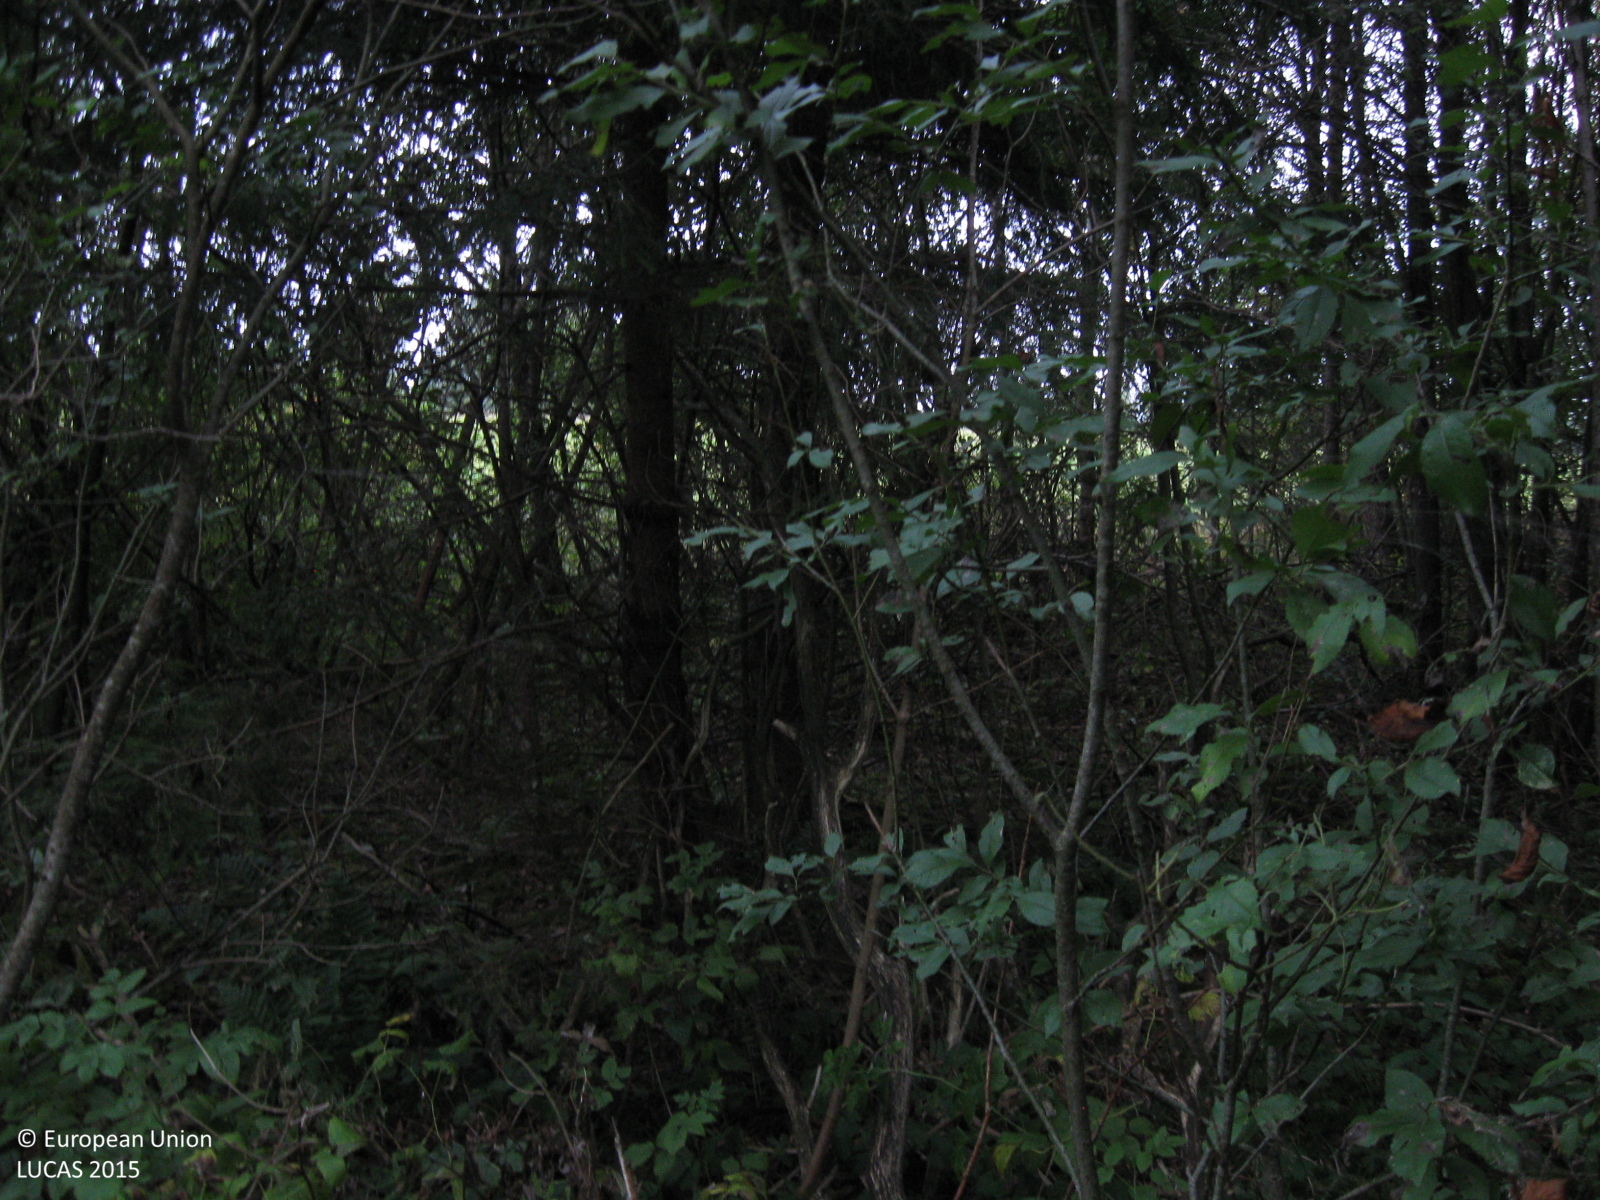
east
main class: Woodland
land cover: Broadleaved woodland
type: non-riverine alder, birch or aspen forest
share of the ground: > 75 %
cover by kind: broadleaved forest trees 90 %, coniferous forest trees 5 %, herbaceous plants 5 %
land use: Forestry
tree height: > 5 m
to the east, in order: Broadleaved woodland; Other leguminous and mixtures for fodder; Spruce dominated mixed woodland
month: August
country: LT
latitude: 55.5418
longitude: 23.3402
